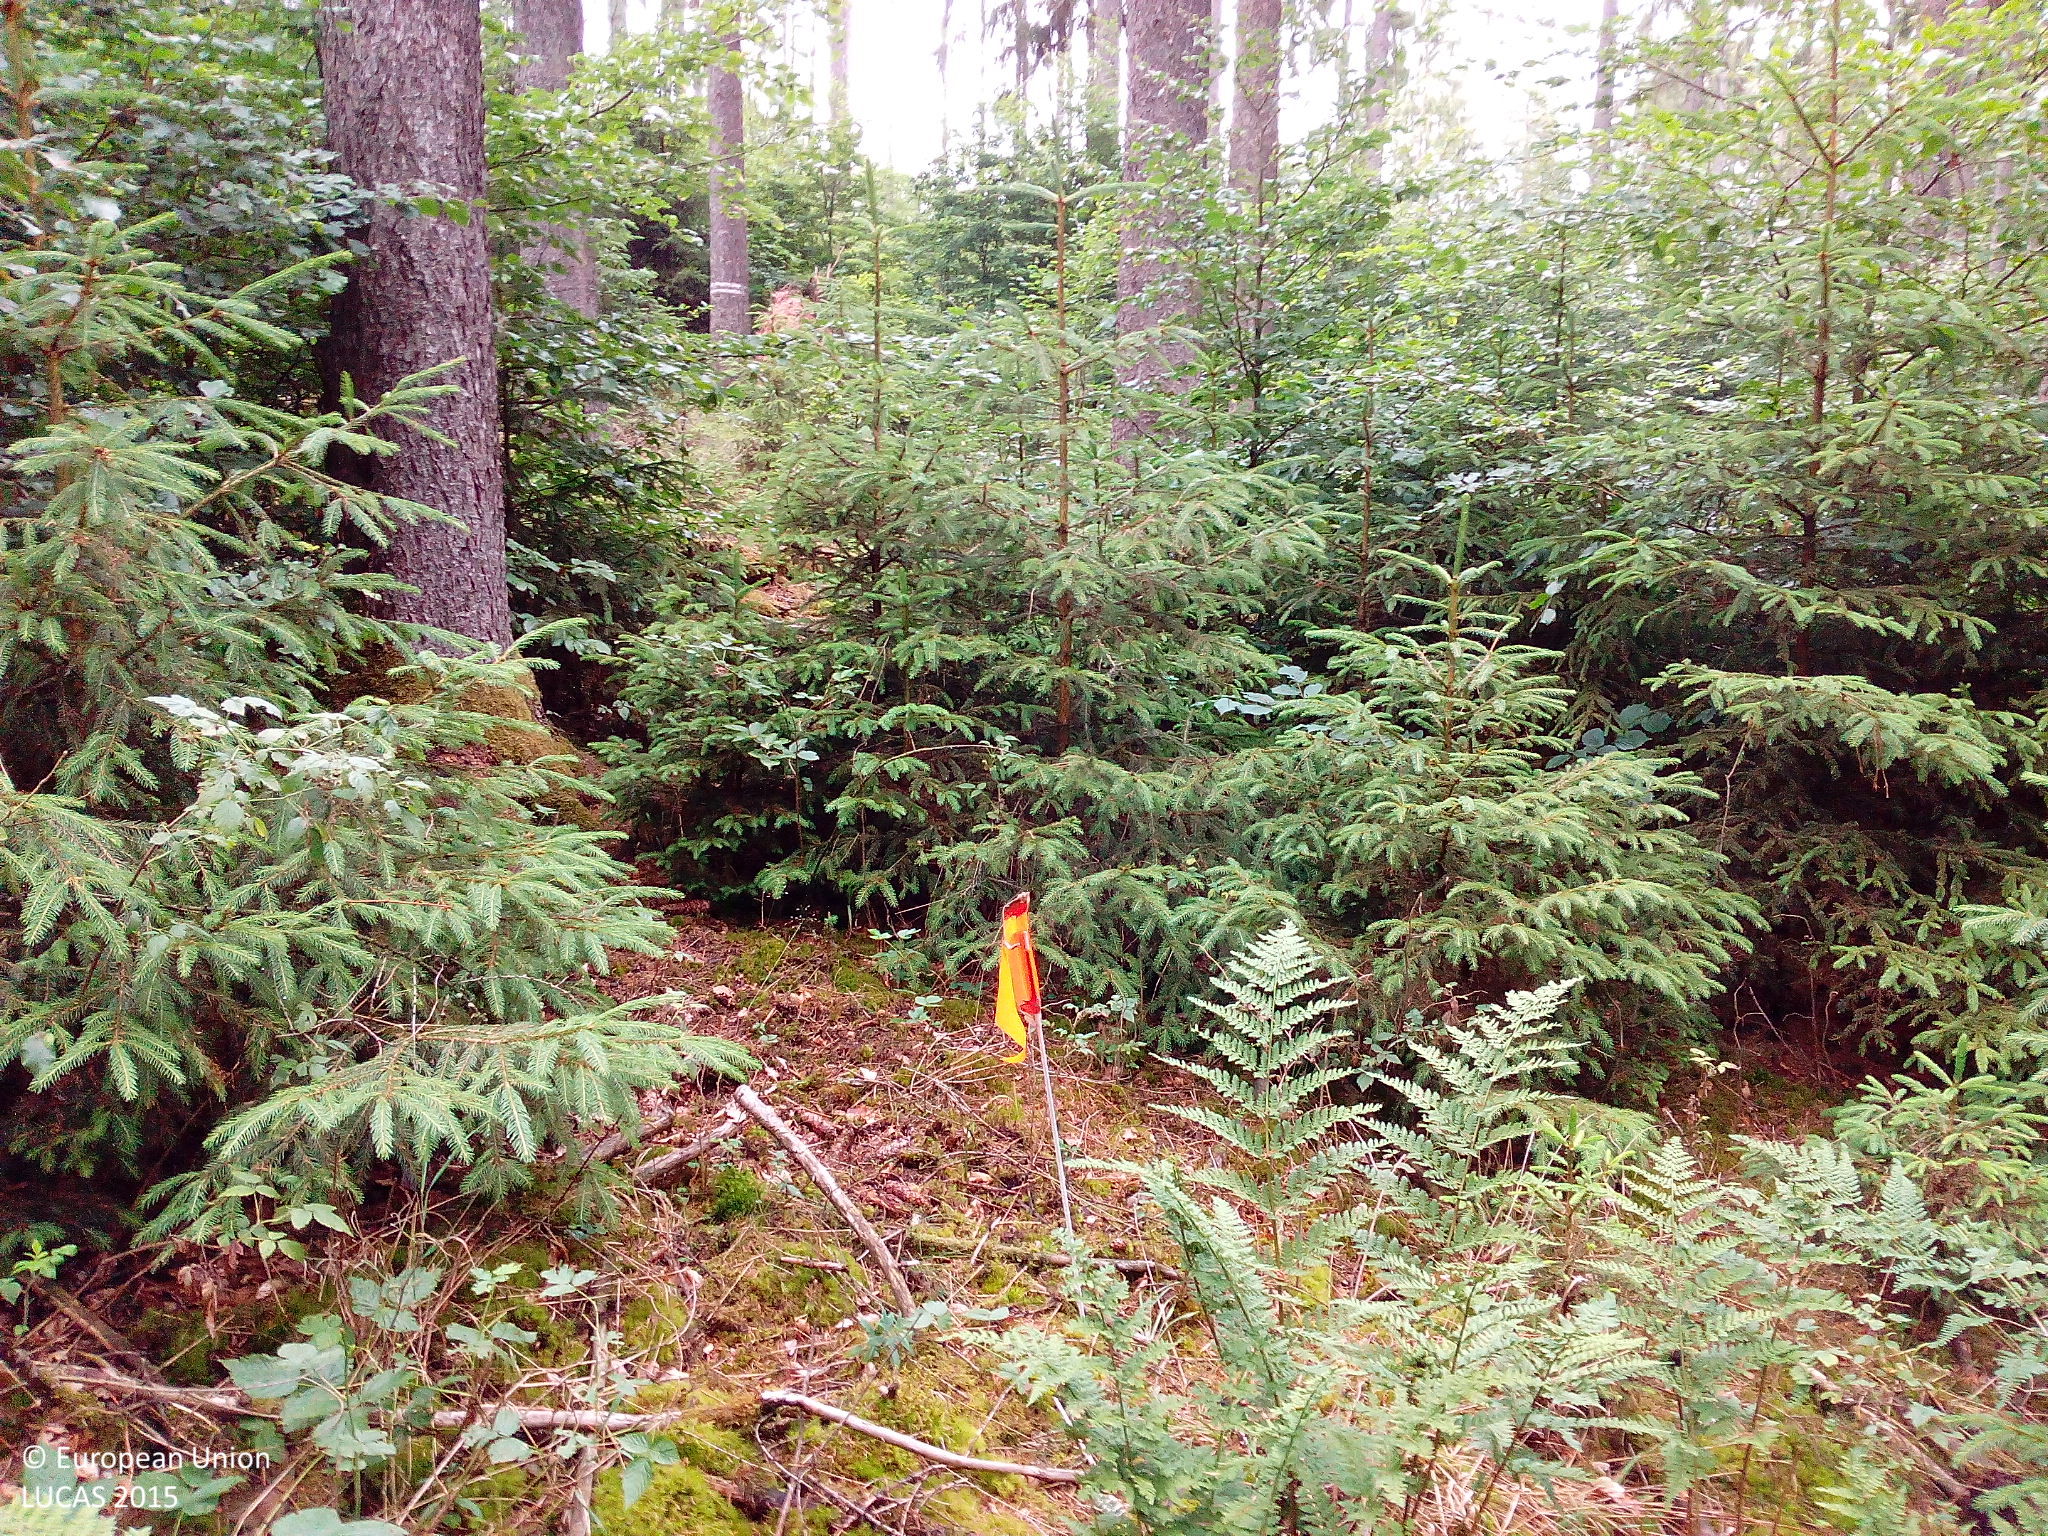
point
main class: Woodland
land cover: Spruce dominated mixed woodland
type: hemiboreal forest and nemoral coniferous forest and mixed broadleaved-coniferous forest
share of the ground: > 75 %
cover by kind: coniferous forest trees 40 %, broadleaved forest trees 30 %, unconsolidated bare surface 20 %, herbaceous plants 5 %, lichens and mosses 5 %
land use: Forestry
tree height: > 5 m
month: July
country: DE
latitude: 51.0292
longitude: 9.8717
